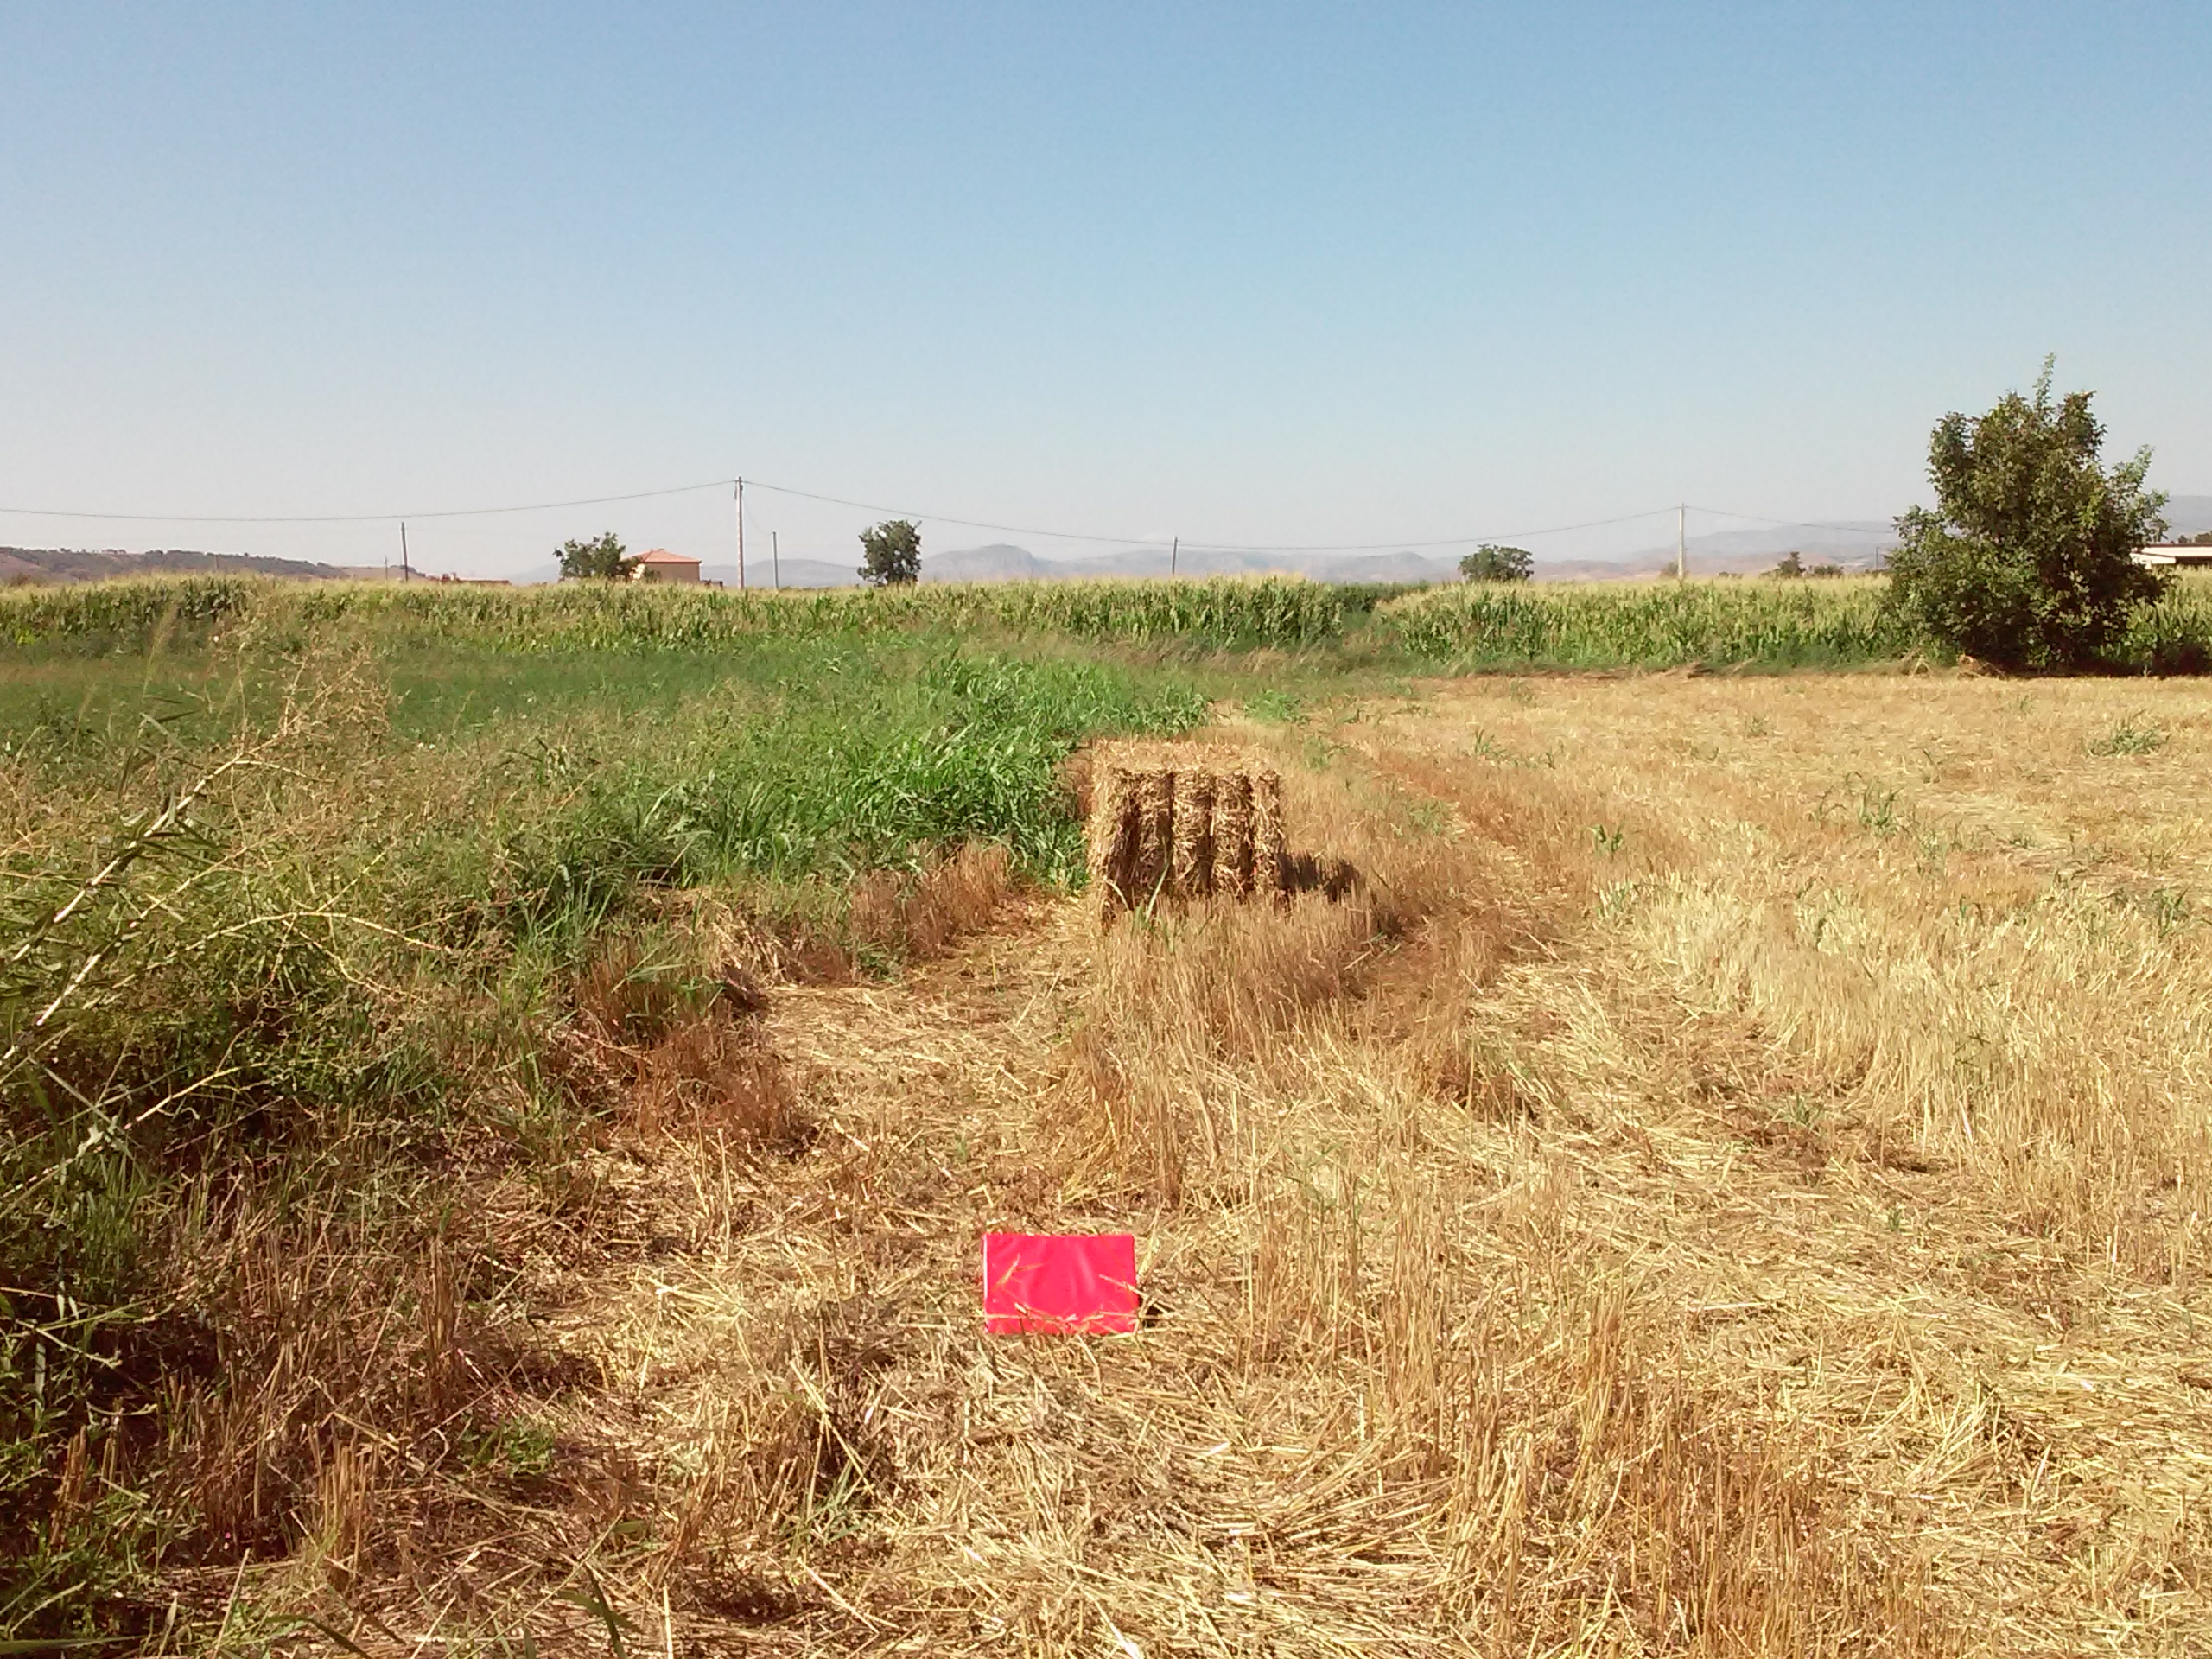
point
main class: Cropland
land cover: Common wheat
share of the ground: < 10 %
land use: Agriculture (excluding fallow land and kitchen gardens)
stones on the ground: 10 - 25 %
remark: Harvested field
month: July
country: ES
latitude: 41.7430
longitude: 0.5954
